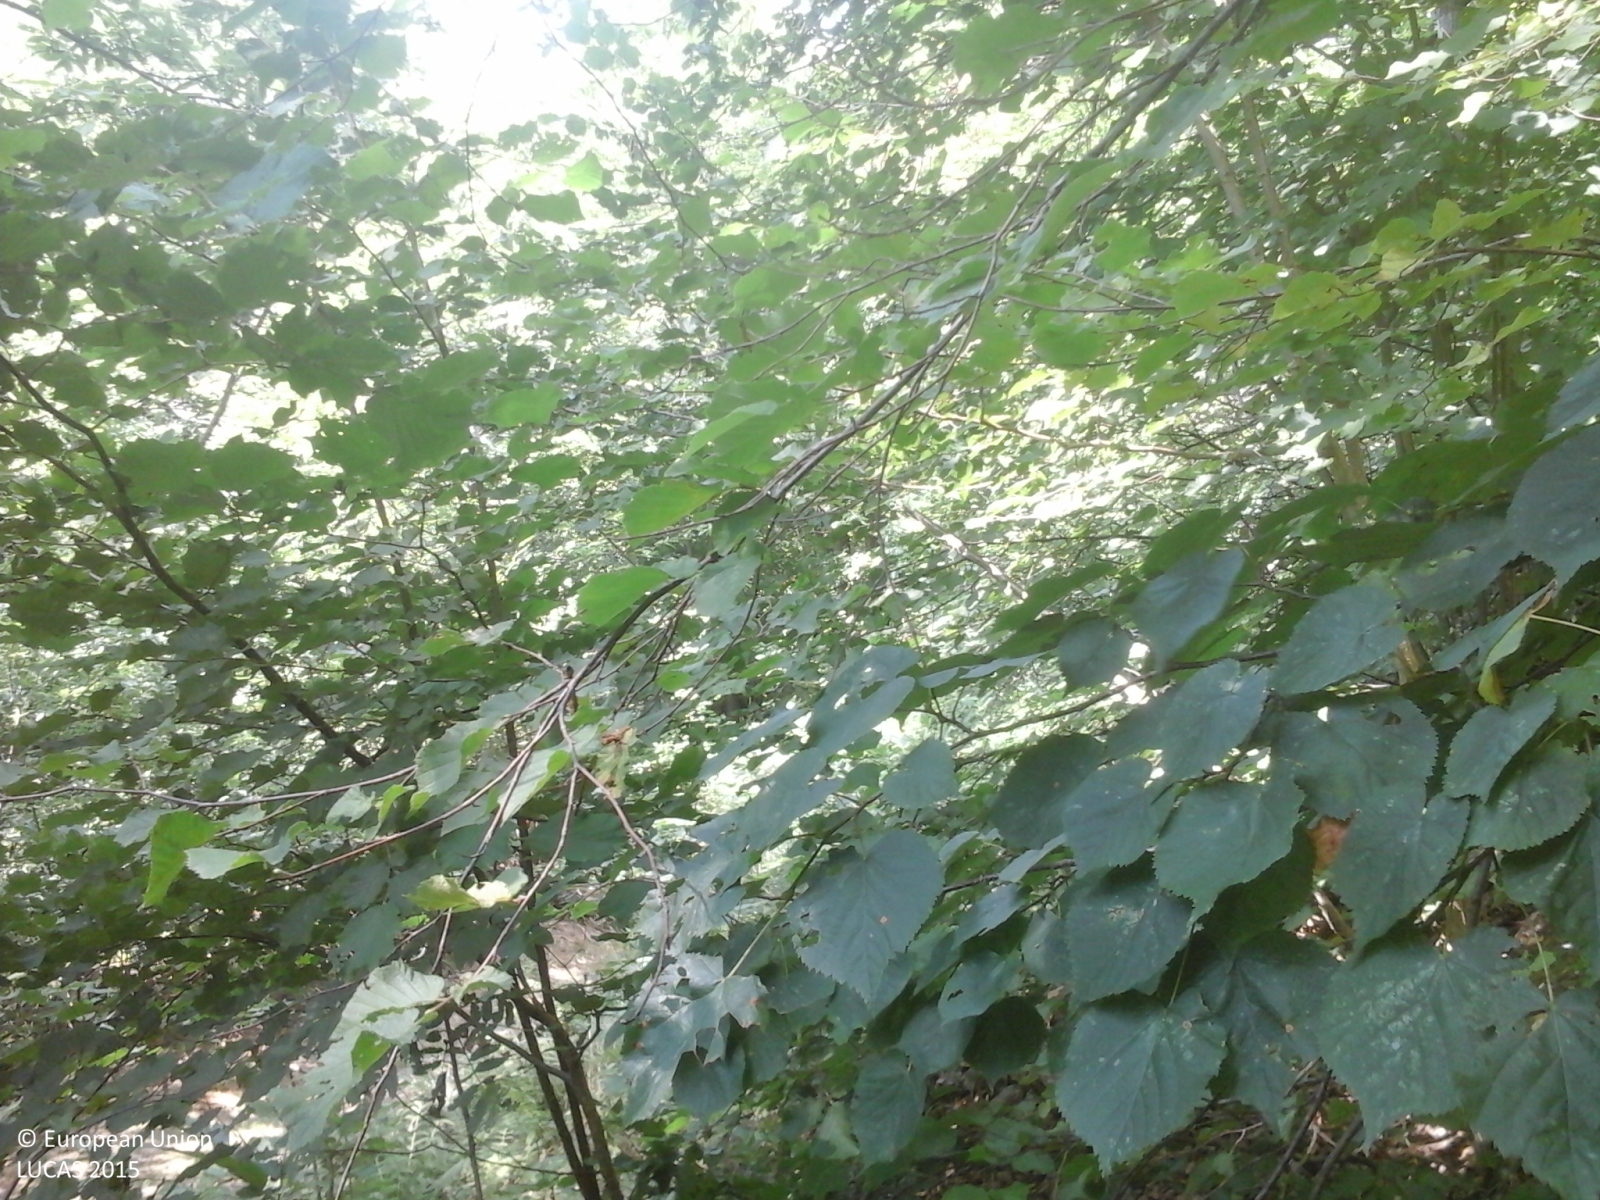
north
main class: Woodland
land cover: Broadleaved woodland
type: thermophilous deciduous forest
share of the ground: > 75 %
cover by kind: broadleaved forest trees 100 %
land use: Forestry
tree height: > 5 m
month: August
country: IT
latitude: 46.0432
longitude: 9.3935
